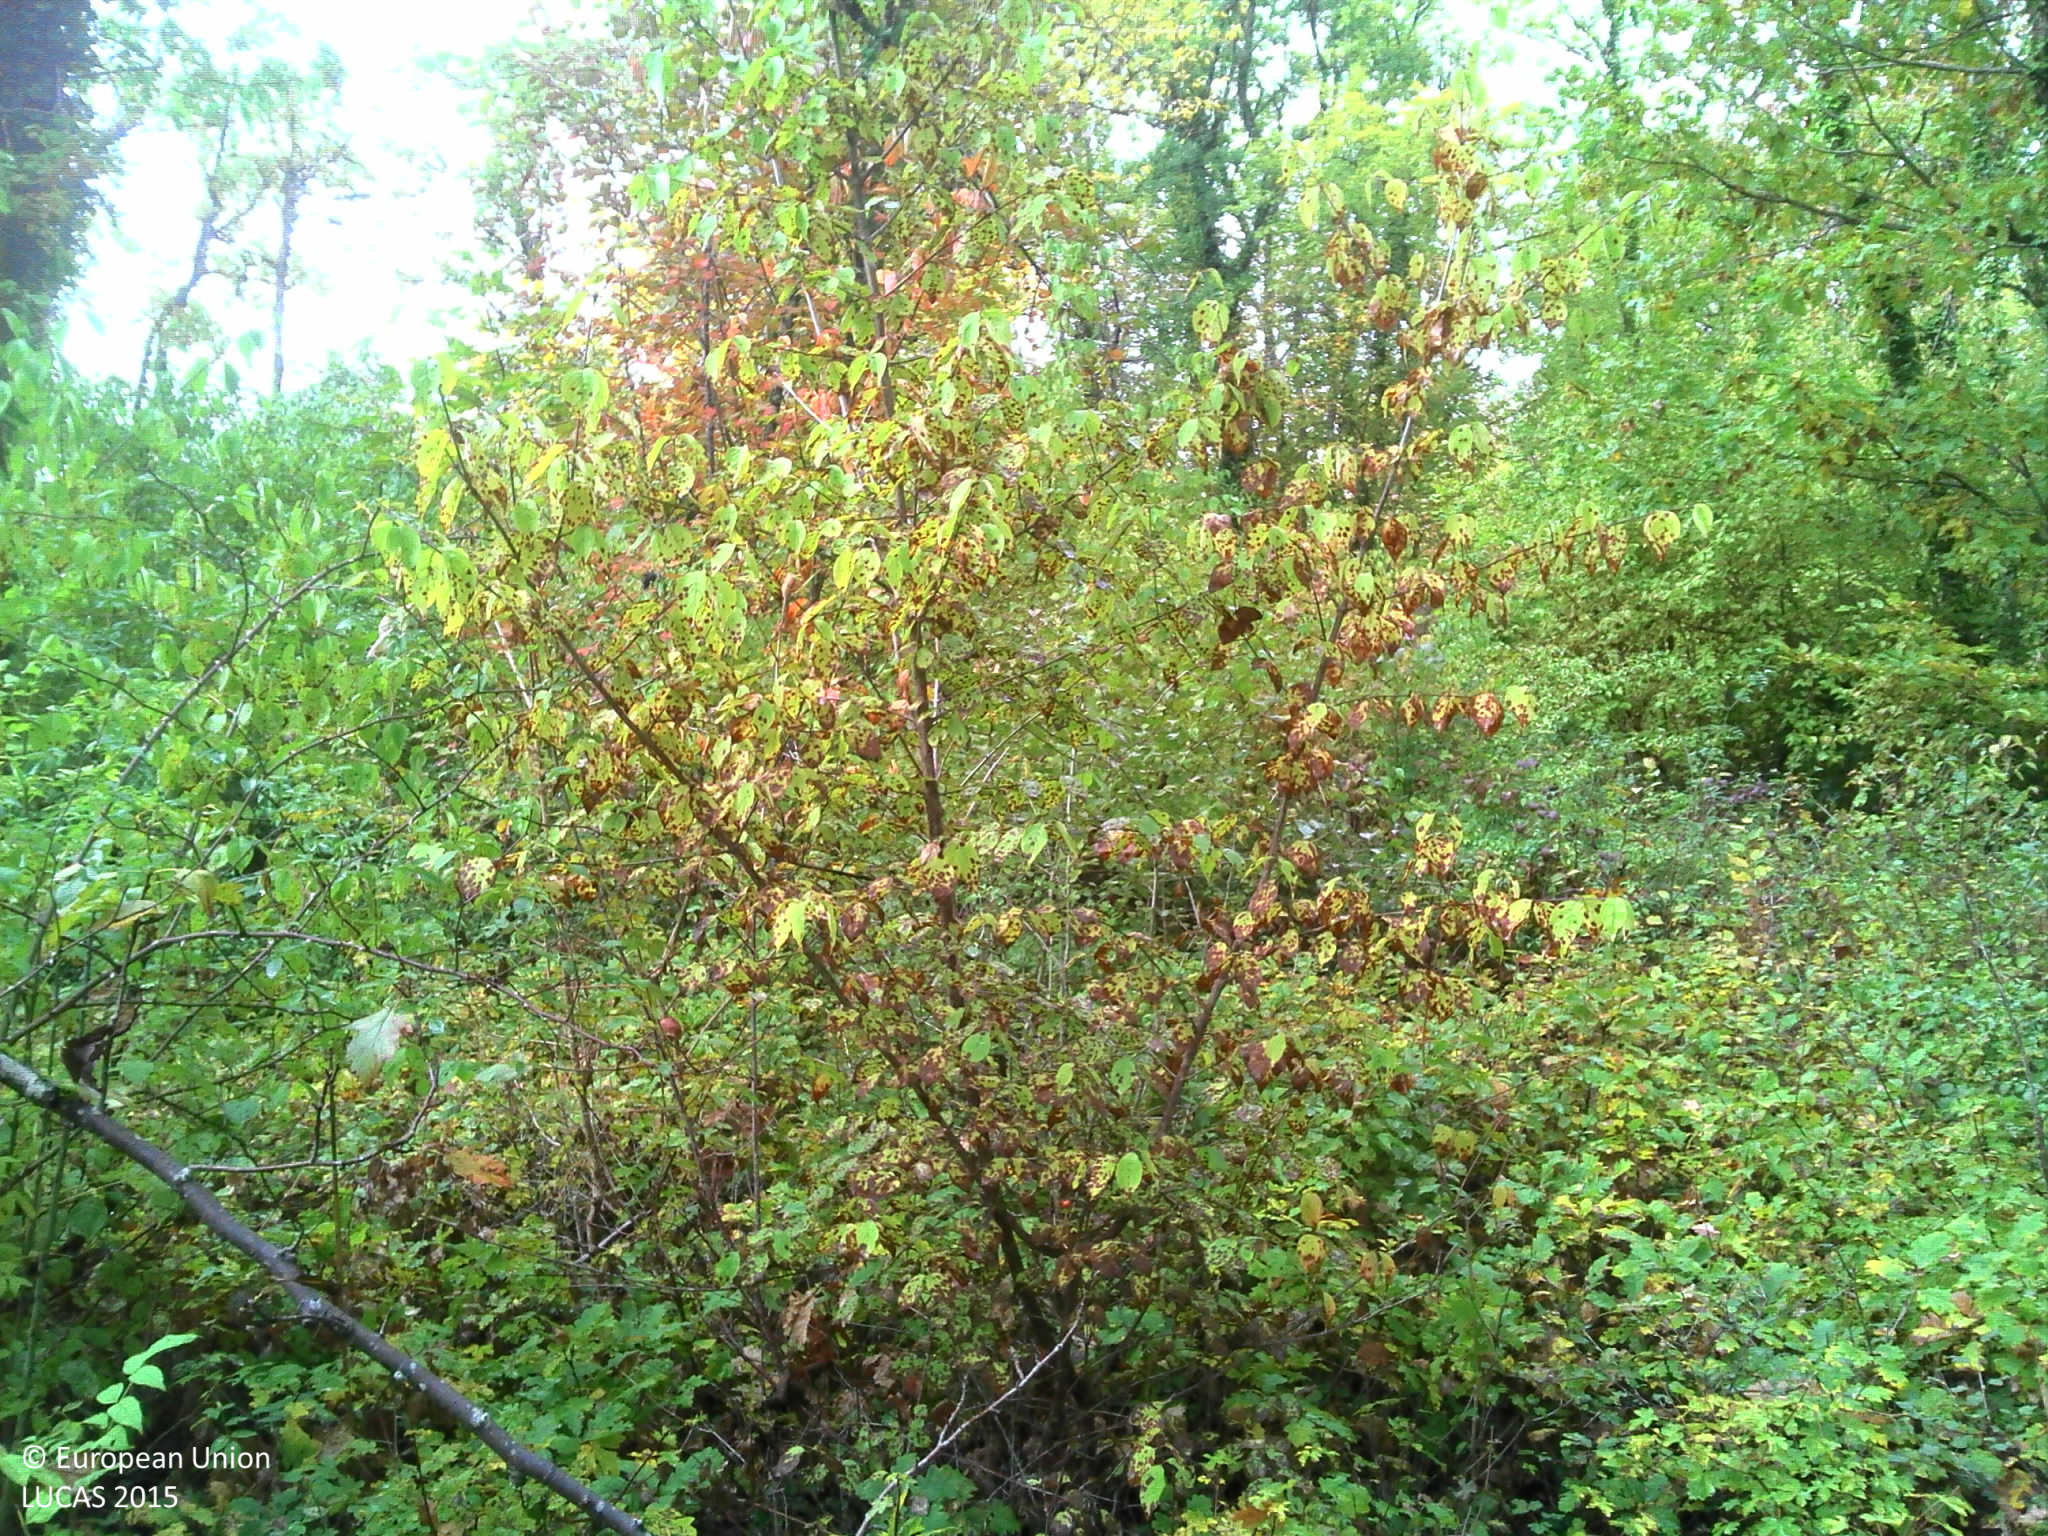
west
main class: Woodland
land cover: Broadleaved woodland
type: mesophytic deciduous forest
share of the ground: > 75 %
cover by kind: broadleaved forest trees 100 %
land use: Forestry
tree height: > 5 m
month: October
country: FR
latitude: 47.3496
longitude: 4.9303
